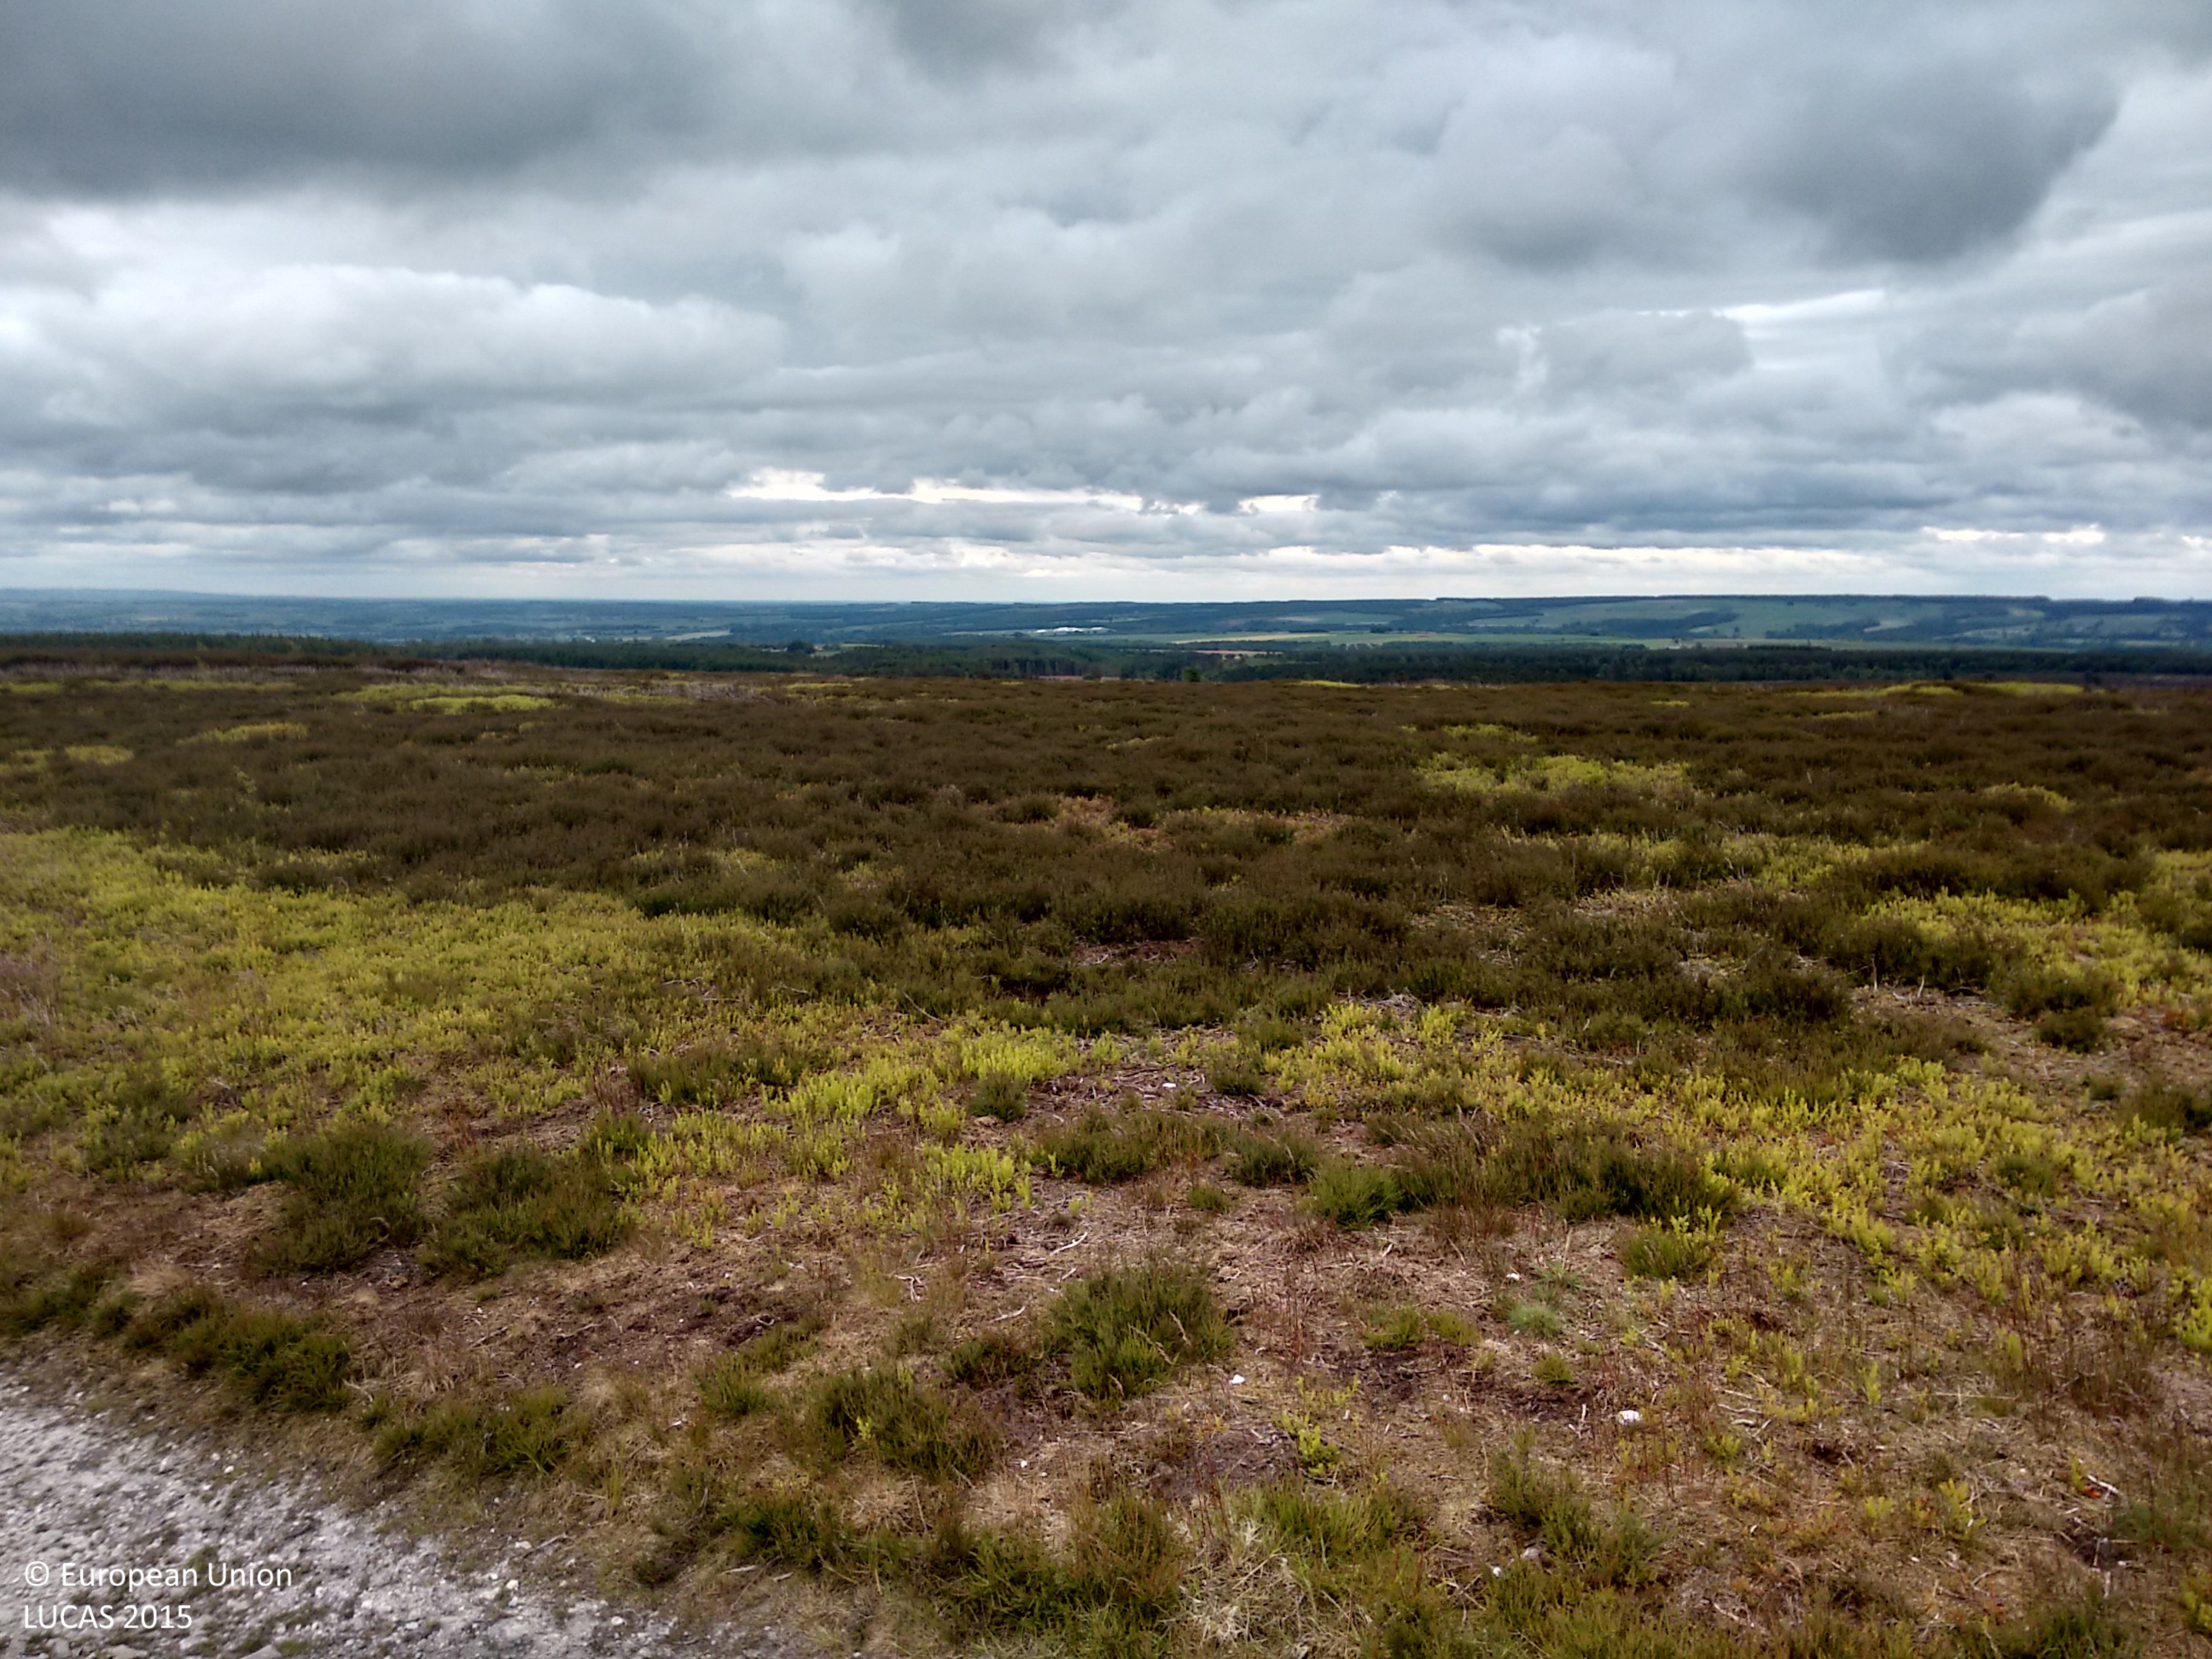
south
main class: Shrubland
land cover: Shrubland without tree cover
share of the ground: > 75 %
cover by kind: shrubs 100 %
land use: Semi-natural and natural areas not in use
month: June
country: GB
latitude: 54.3067
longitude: -1.0936
